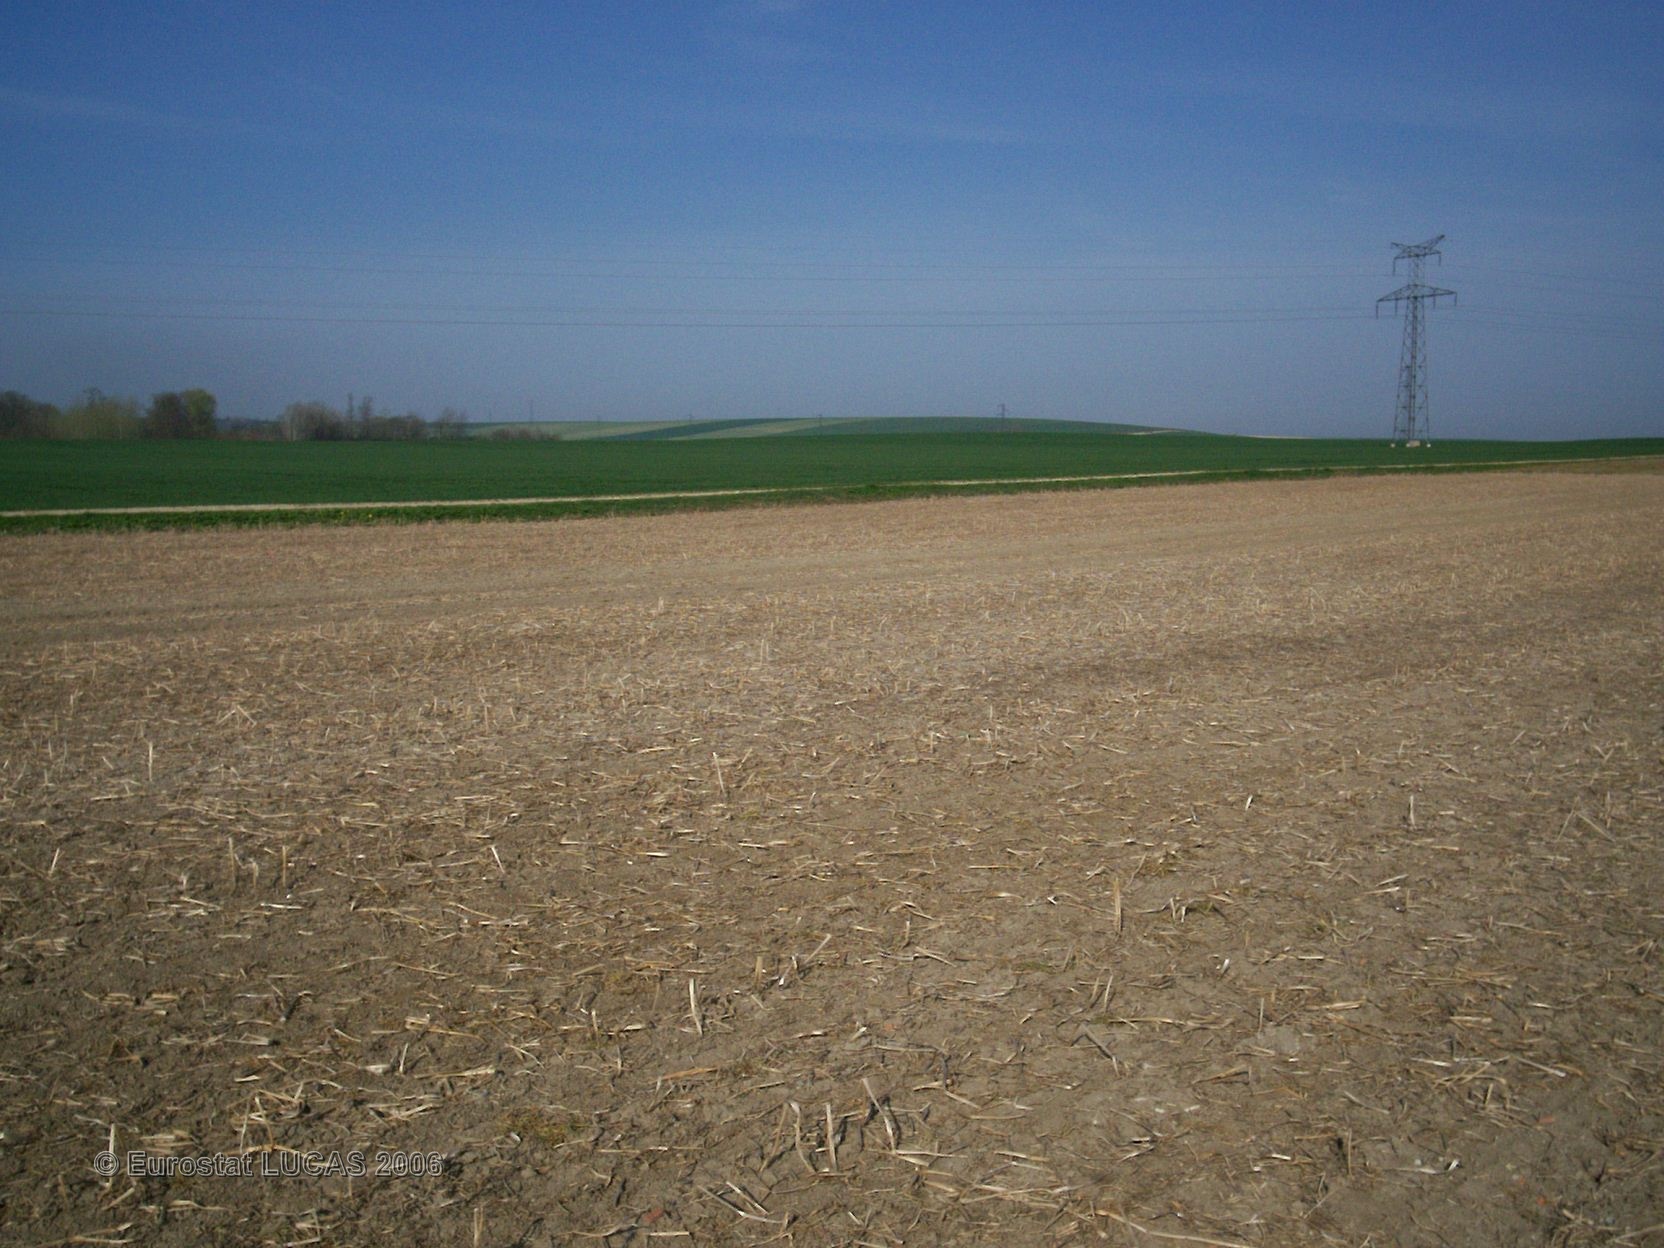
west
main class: Cropland
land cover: Sugar beet
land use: Agriculture (excluding fallow land and kitchen gardens)
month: April
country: FR
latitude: 48.4660
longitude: 4.5198
